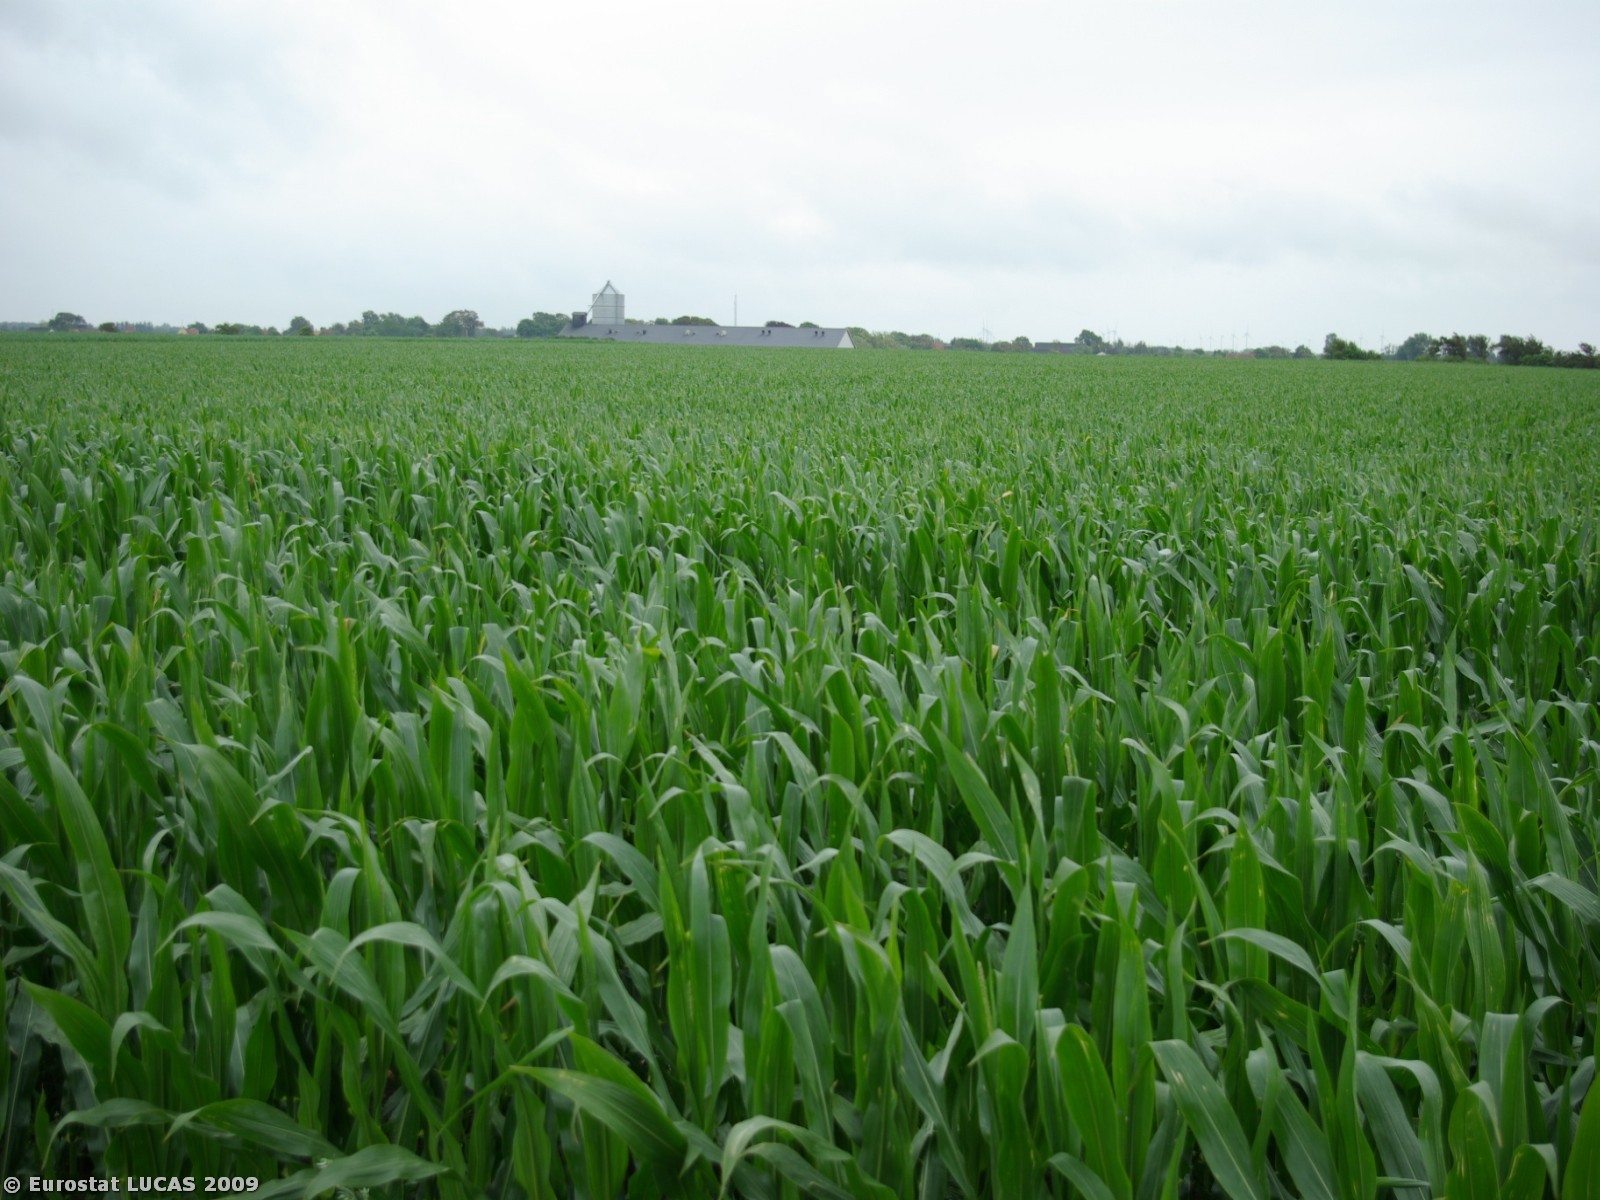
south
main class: Cropland
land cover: Maize
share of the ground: > 75 %
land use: Agriculture (excluding fallow land and kitchen gardens)
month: July
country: DK
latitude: 55.0843
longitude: 8.6694
